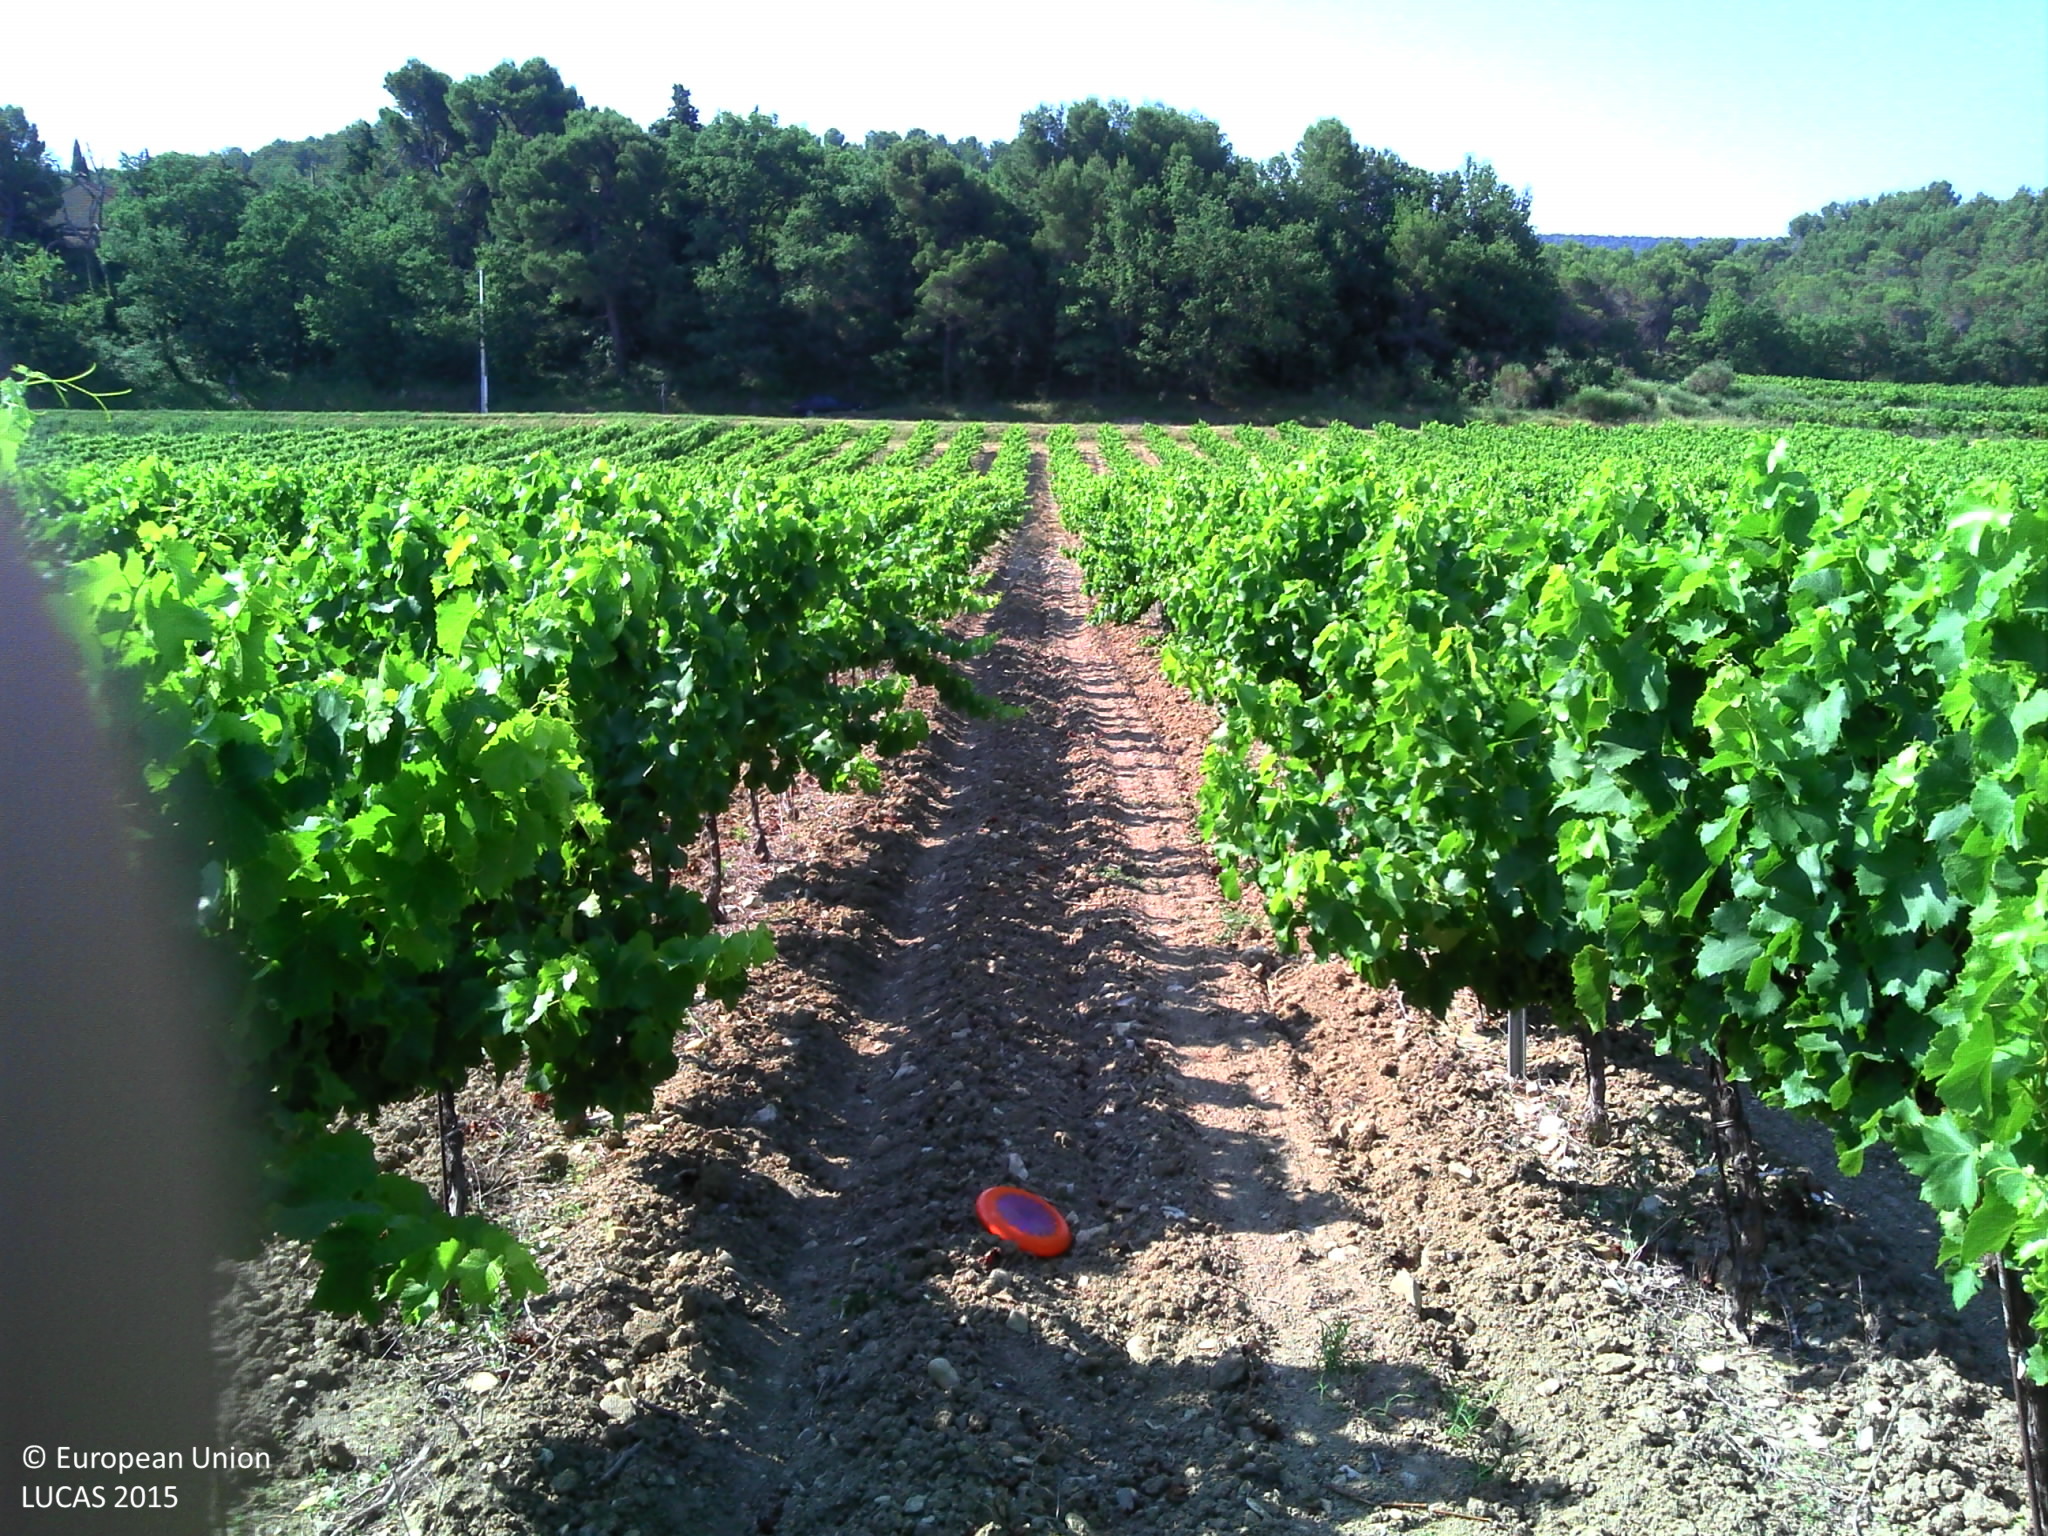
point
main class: Cropland
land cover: Vineyards
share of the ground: 50 - 75 %
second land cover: Other bare soil
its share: > 75 %
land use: Agriculture (excluding fallow land and kitchen gardens)
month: July
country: FR
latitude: 44.2846
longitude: 5.0077
